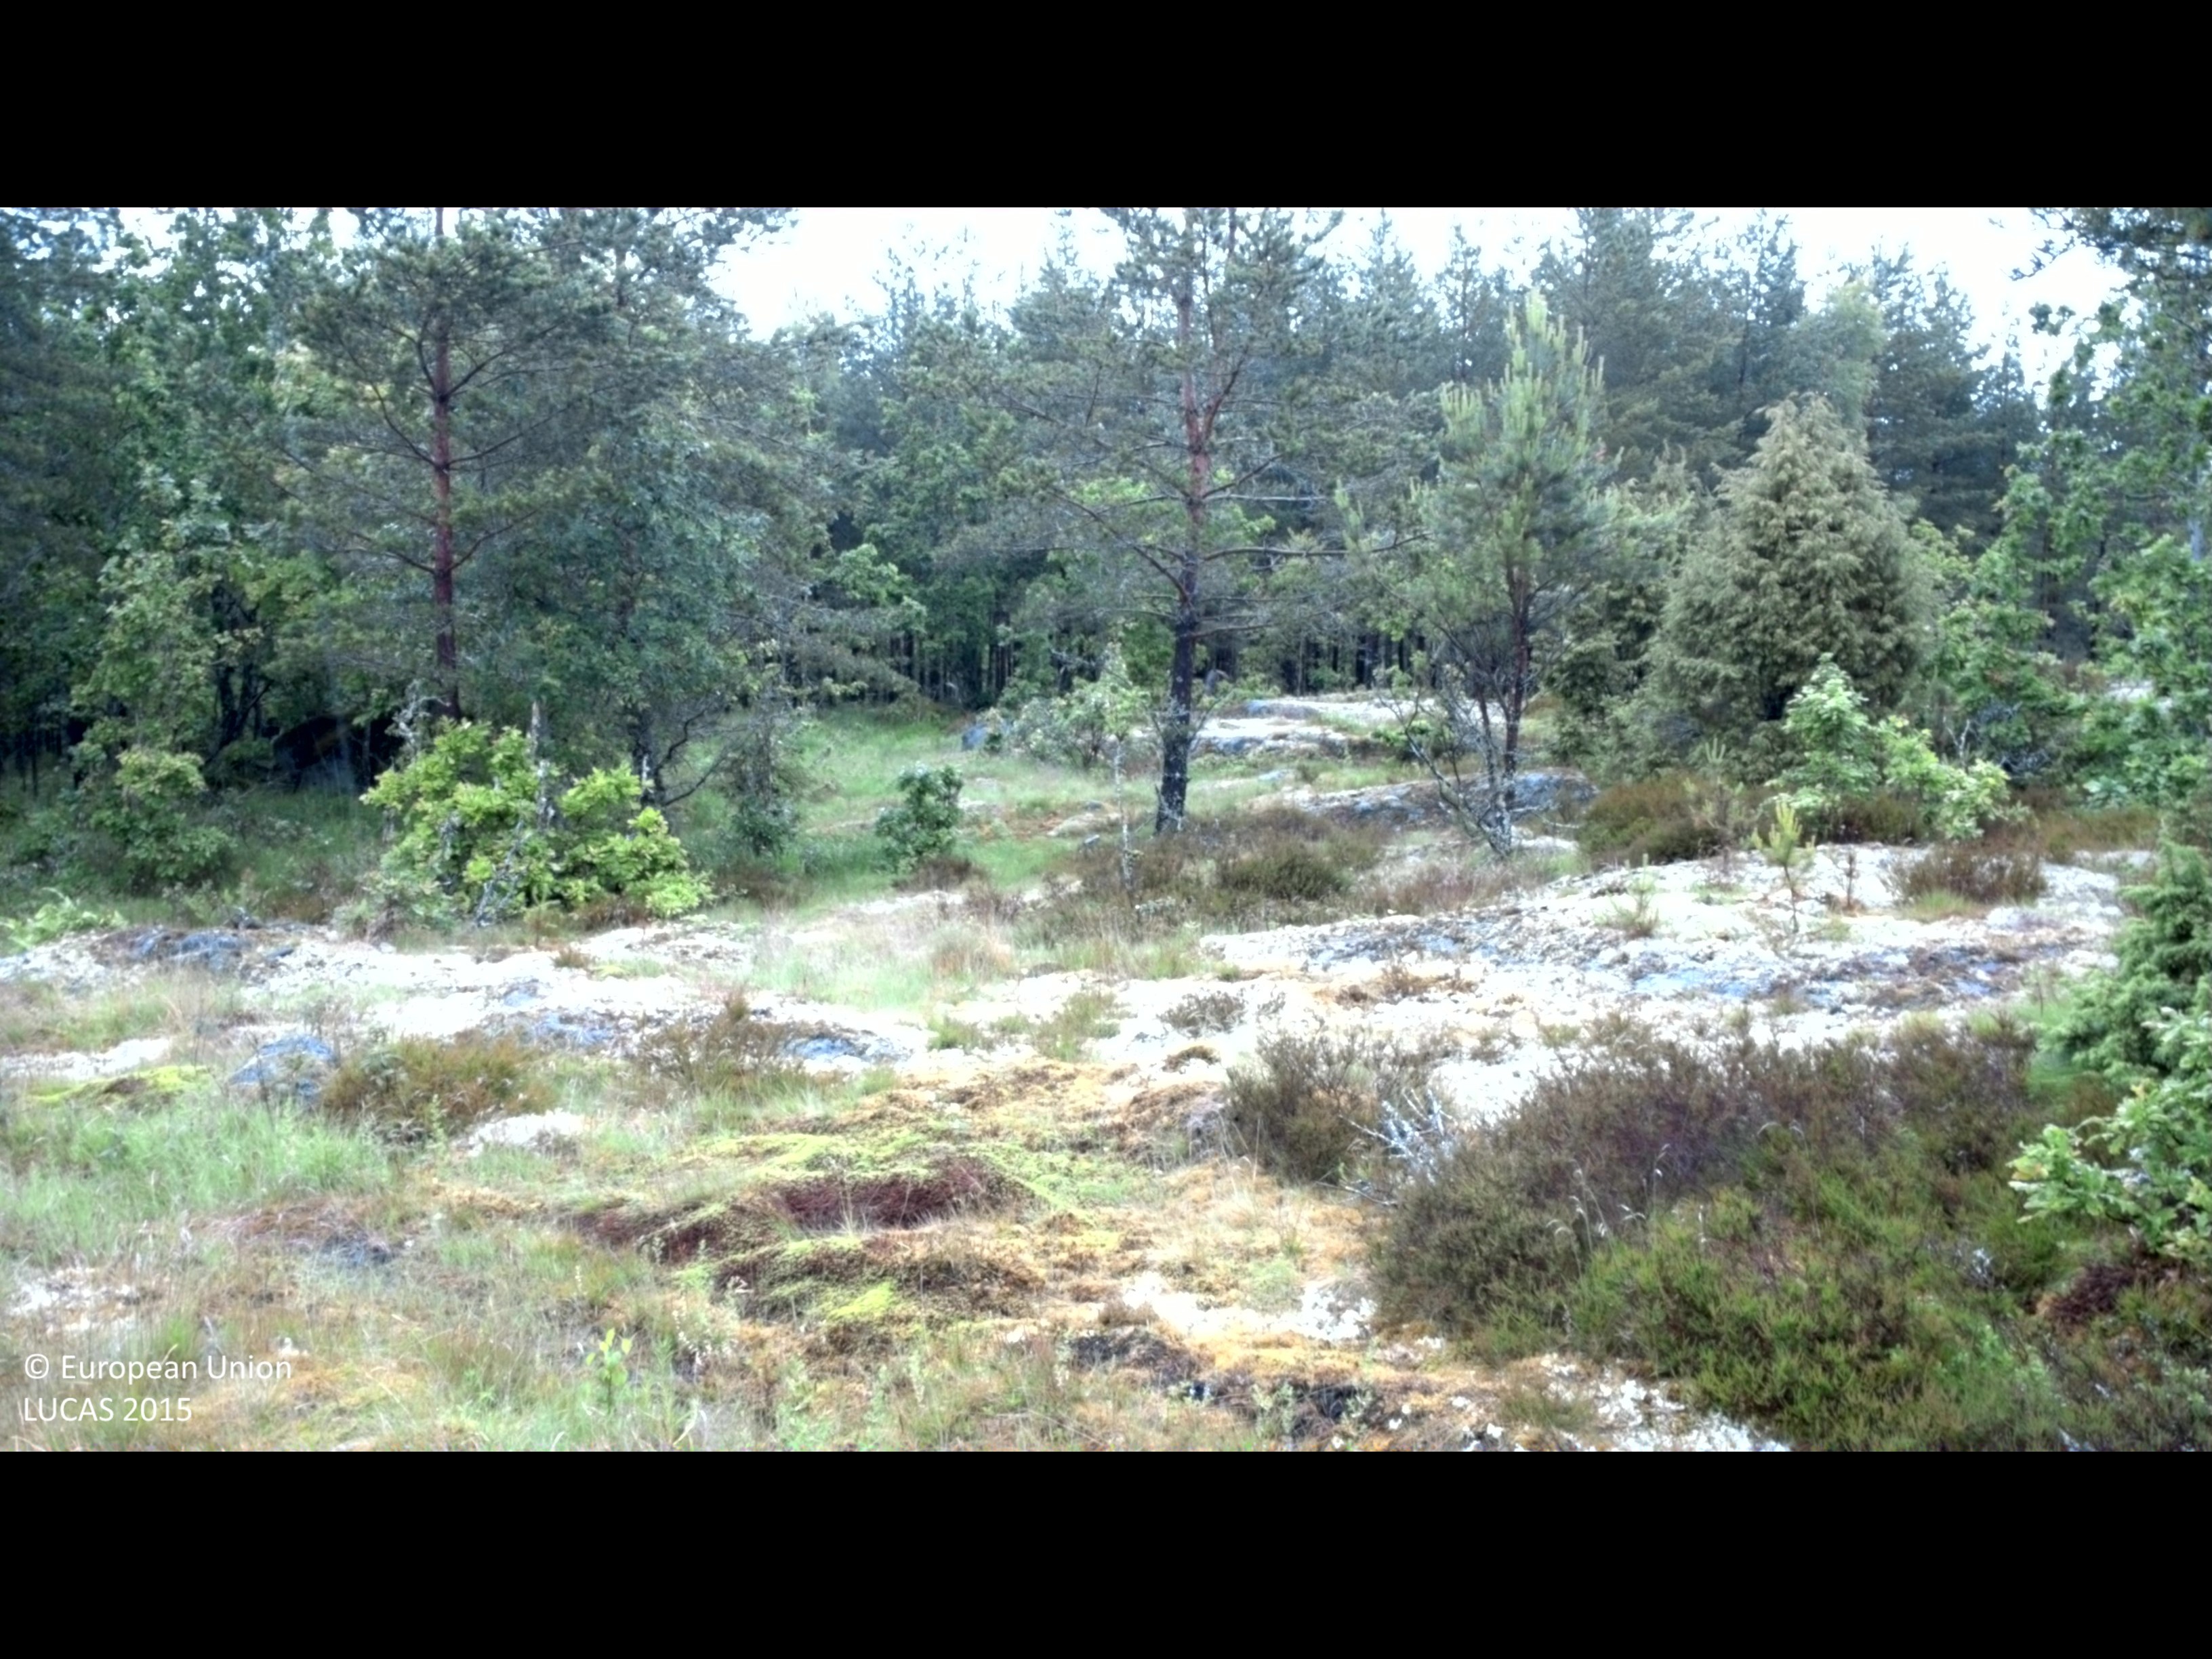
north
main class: Woodland
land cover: Pine dominated mixed woodland
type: boreal forest
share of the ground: 10 - 25 %
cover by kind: shrubs 50 %, lichens and mosses 25 %, coniferous forest trees 10 %, herbaceous plants 10 %, broadleaved forest trees 5 %
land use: Semi-natural and natural areas not in use
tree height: > 5 m
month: June
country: SE
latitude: 57.9993
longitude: 16.3079
